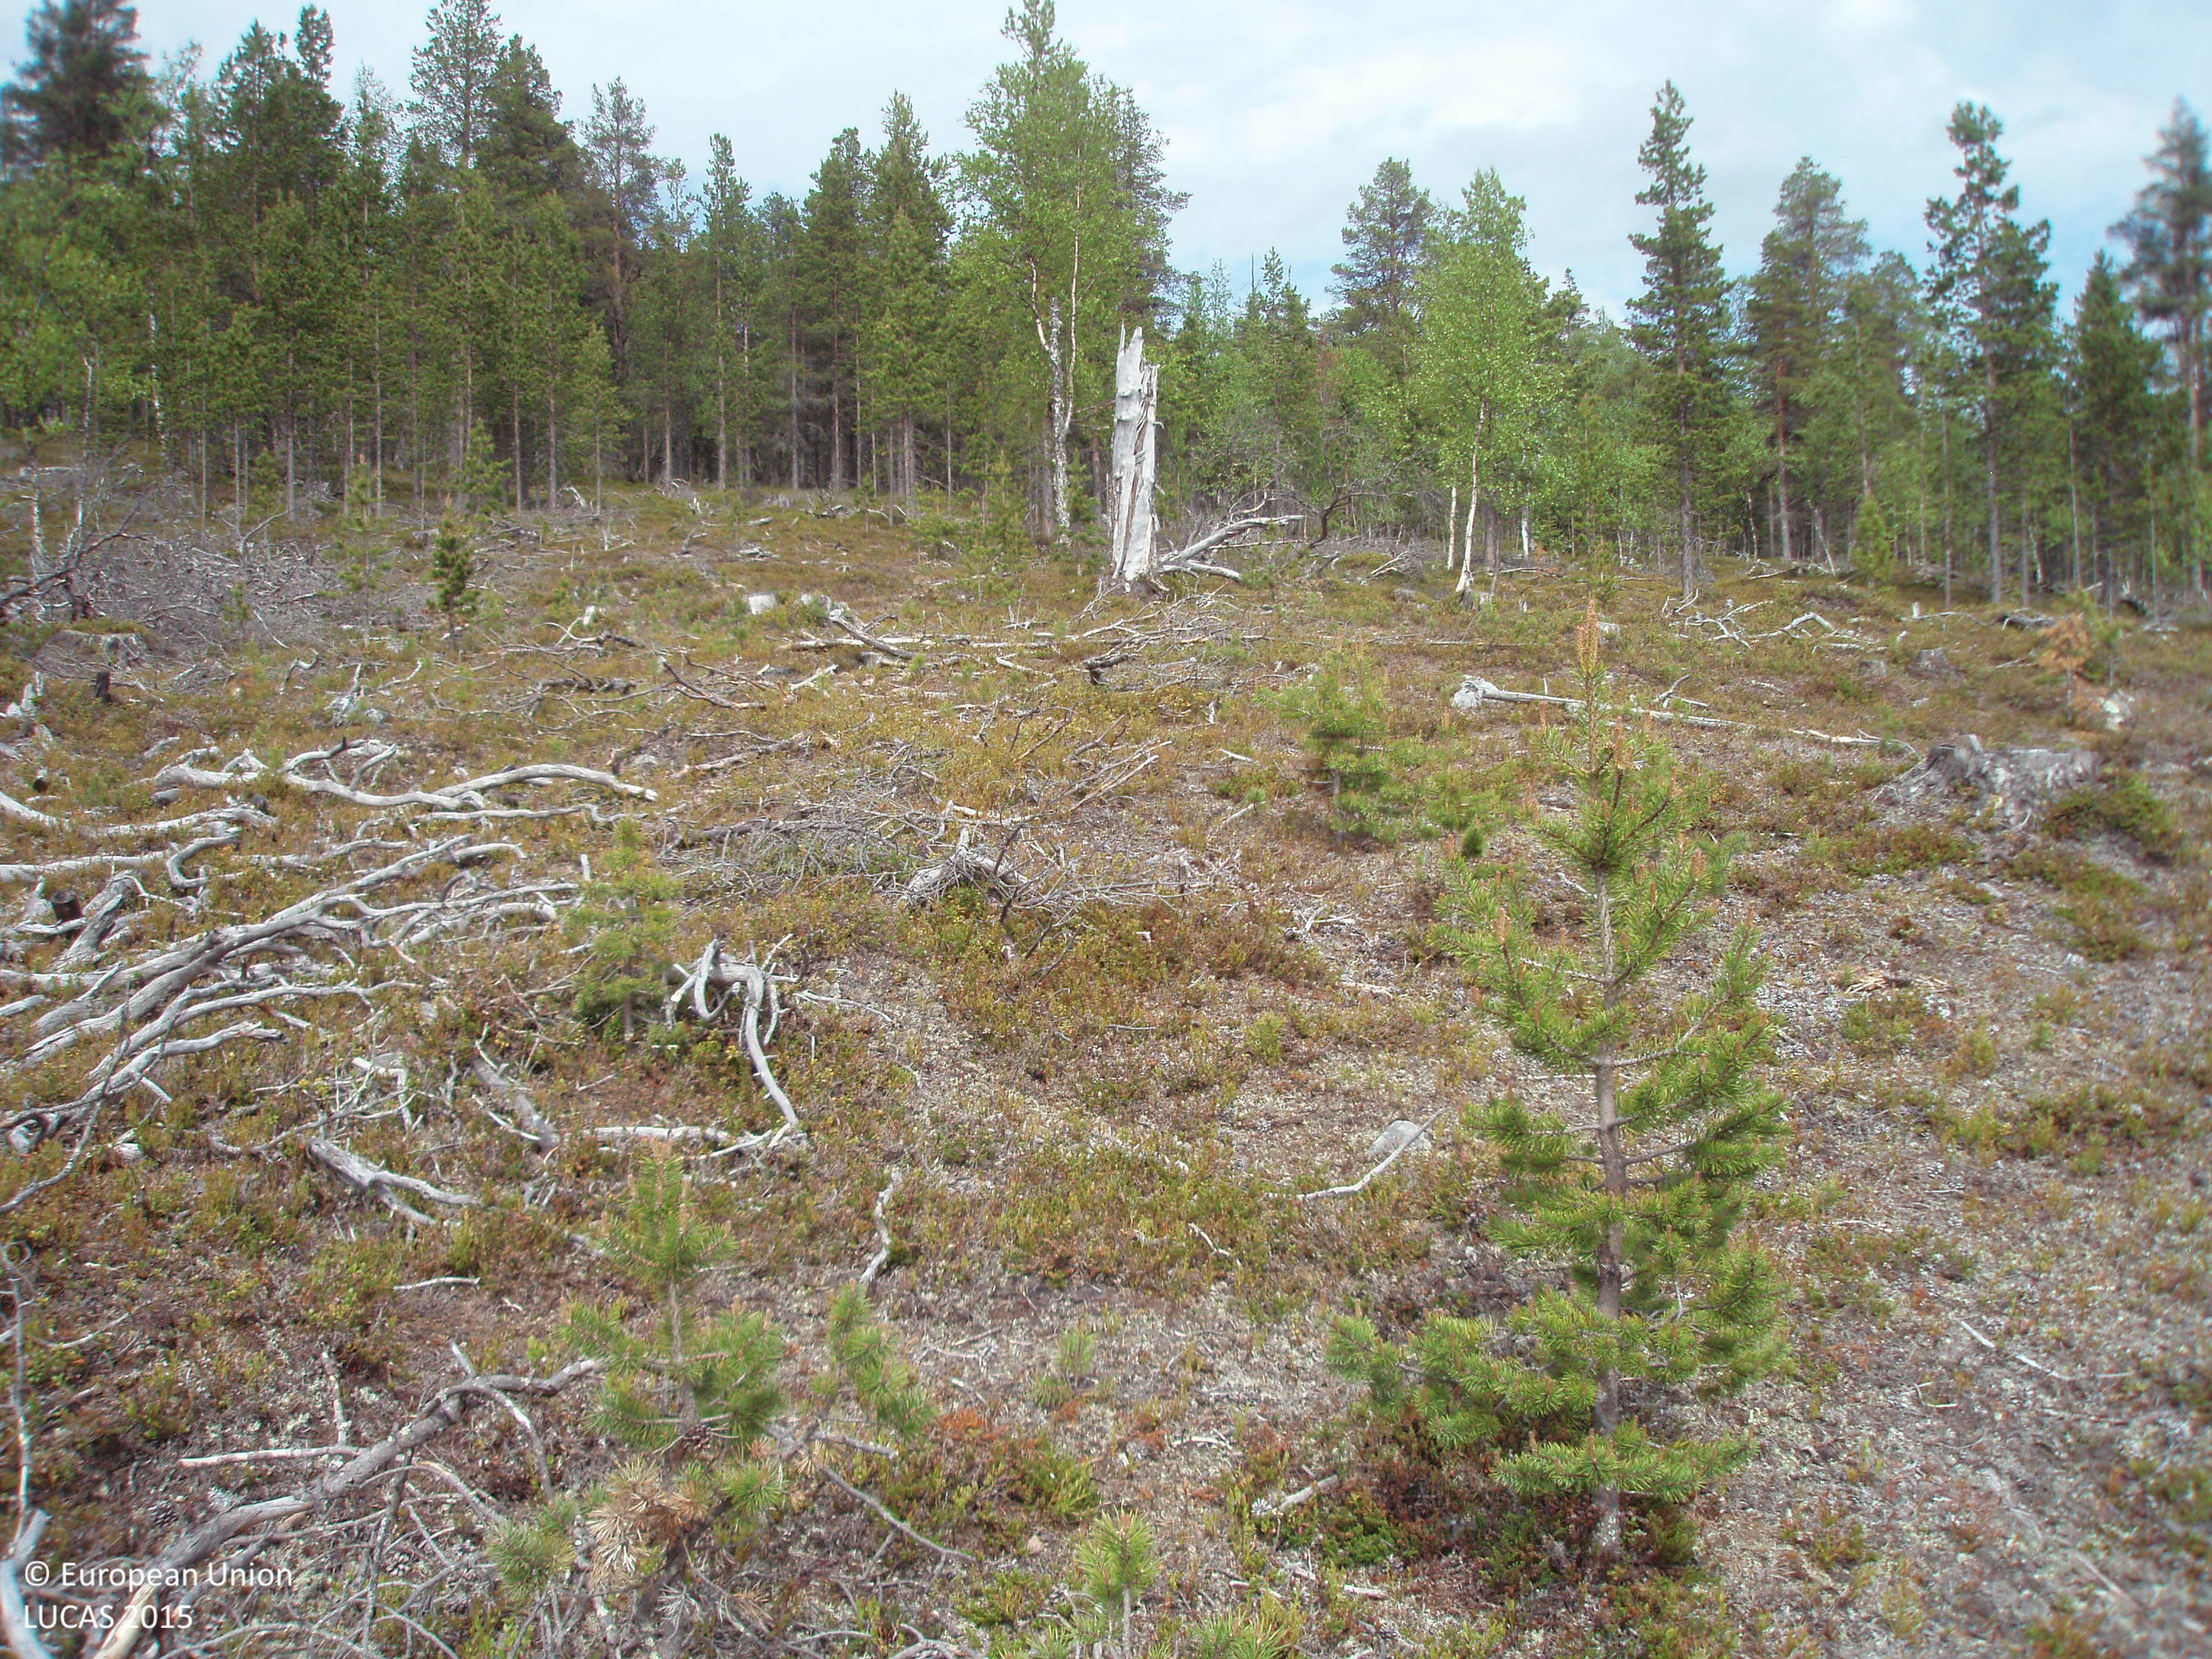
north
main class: Shrubland
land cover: Shrubland with sparse tree cover
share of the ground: > 75 %
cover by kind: shrubs 85 %, coniferous forest trees 5 %, lichens and mosses 5 %, unconsolidated bare surface 5 %
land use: Forestry
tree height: < 5 m
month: June
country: FI
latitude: 68.7971
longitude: 26.6271
